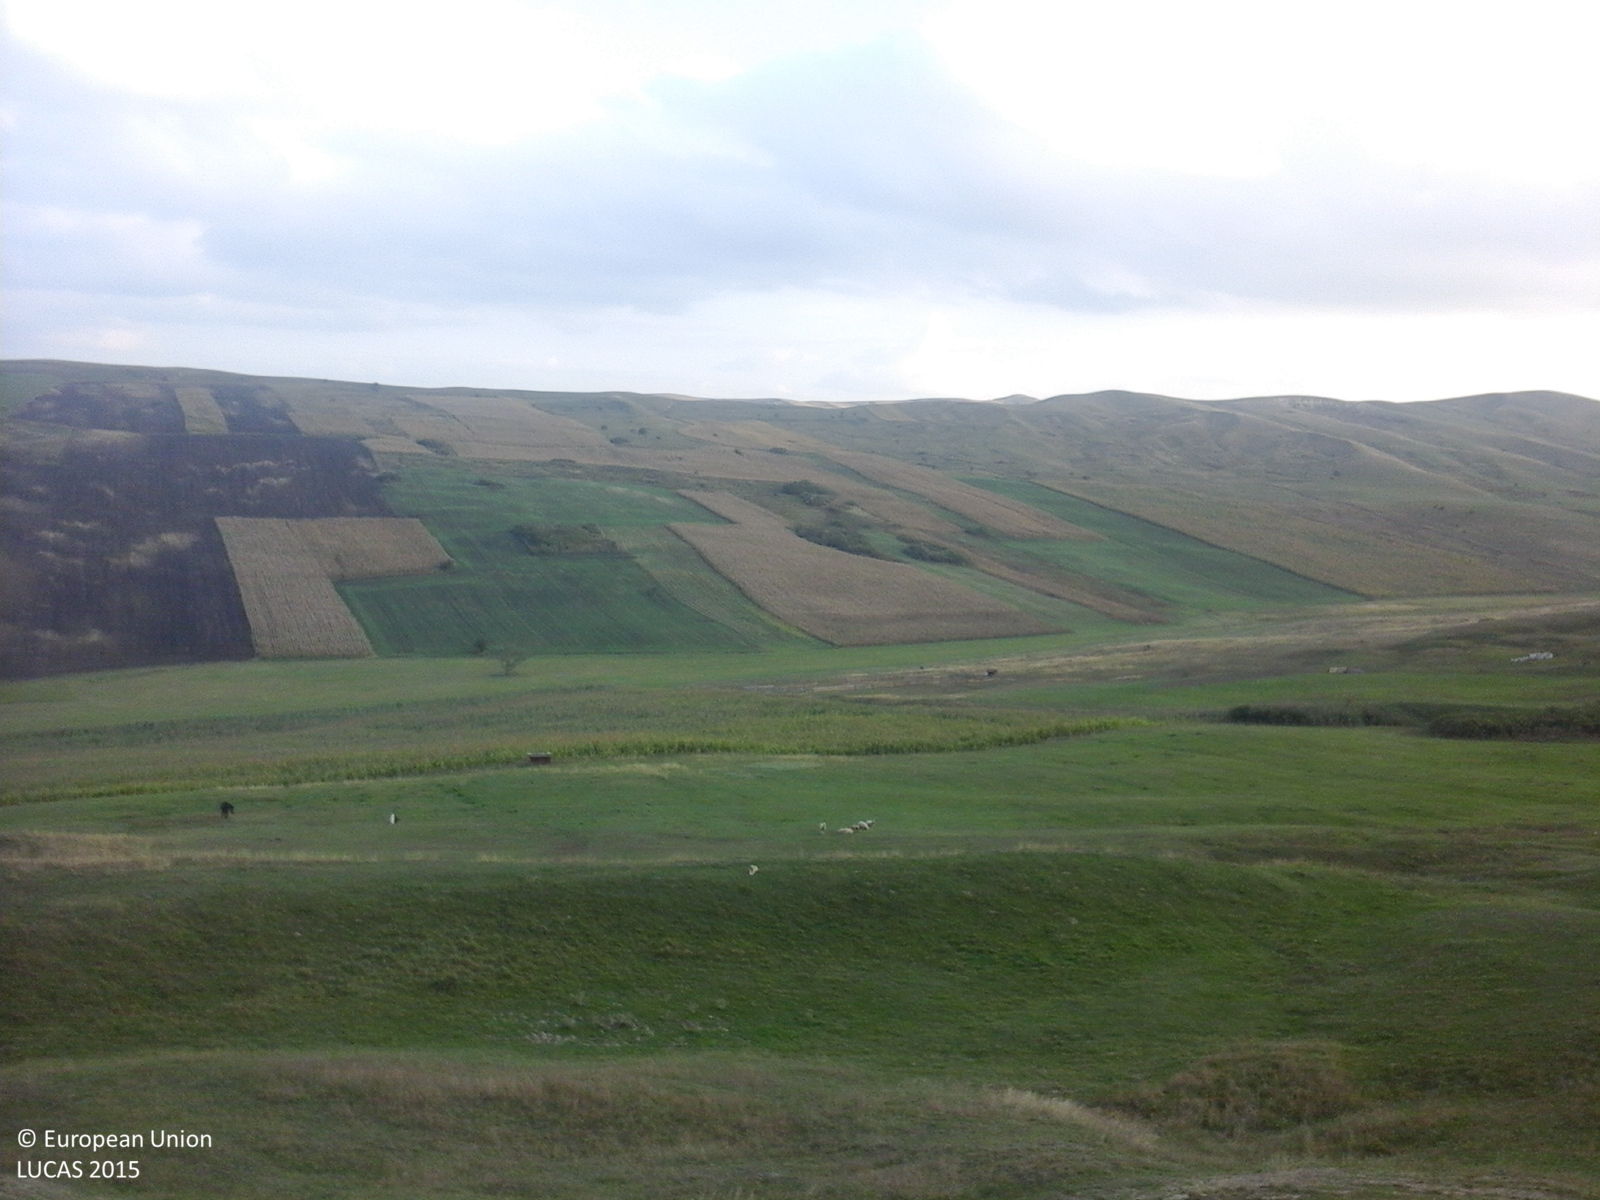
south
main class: Grassland
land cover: Grassland without tree/shrub cover
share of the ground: > 75 %
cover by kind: herbaceous plants 100 %
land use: Agriculture (excluding fallow land and kitchen gardens)
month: October
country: RO
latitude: 46.2582
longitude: 23.9157
